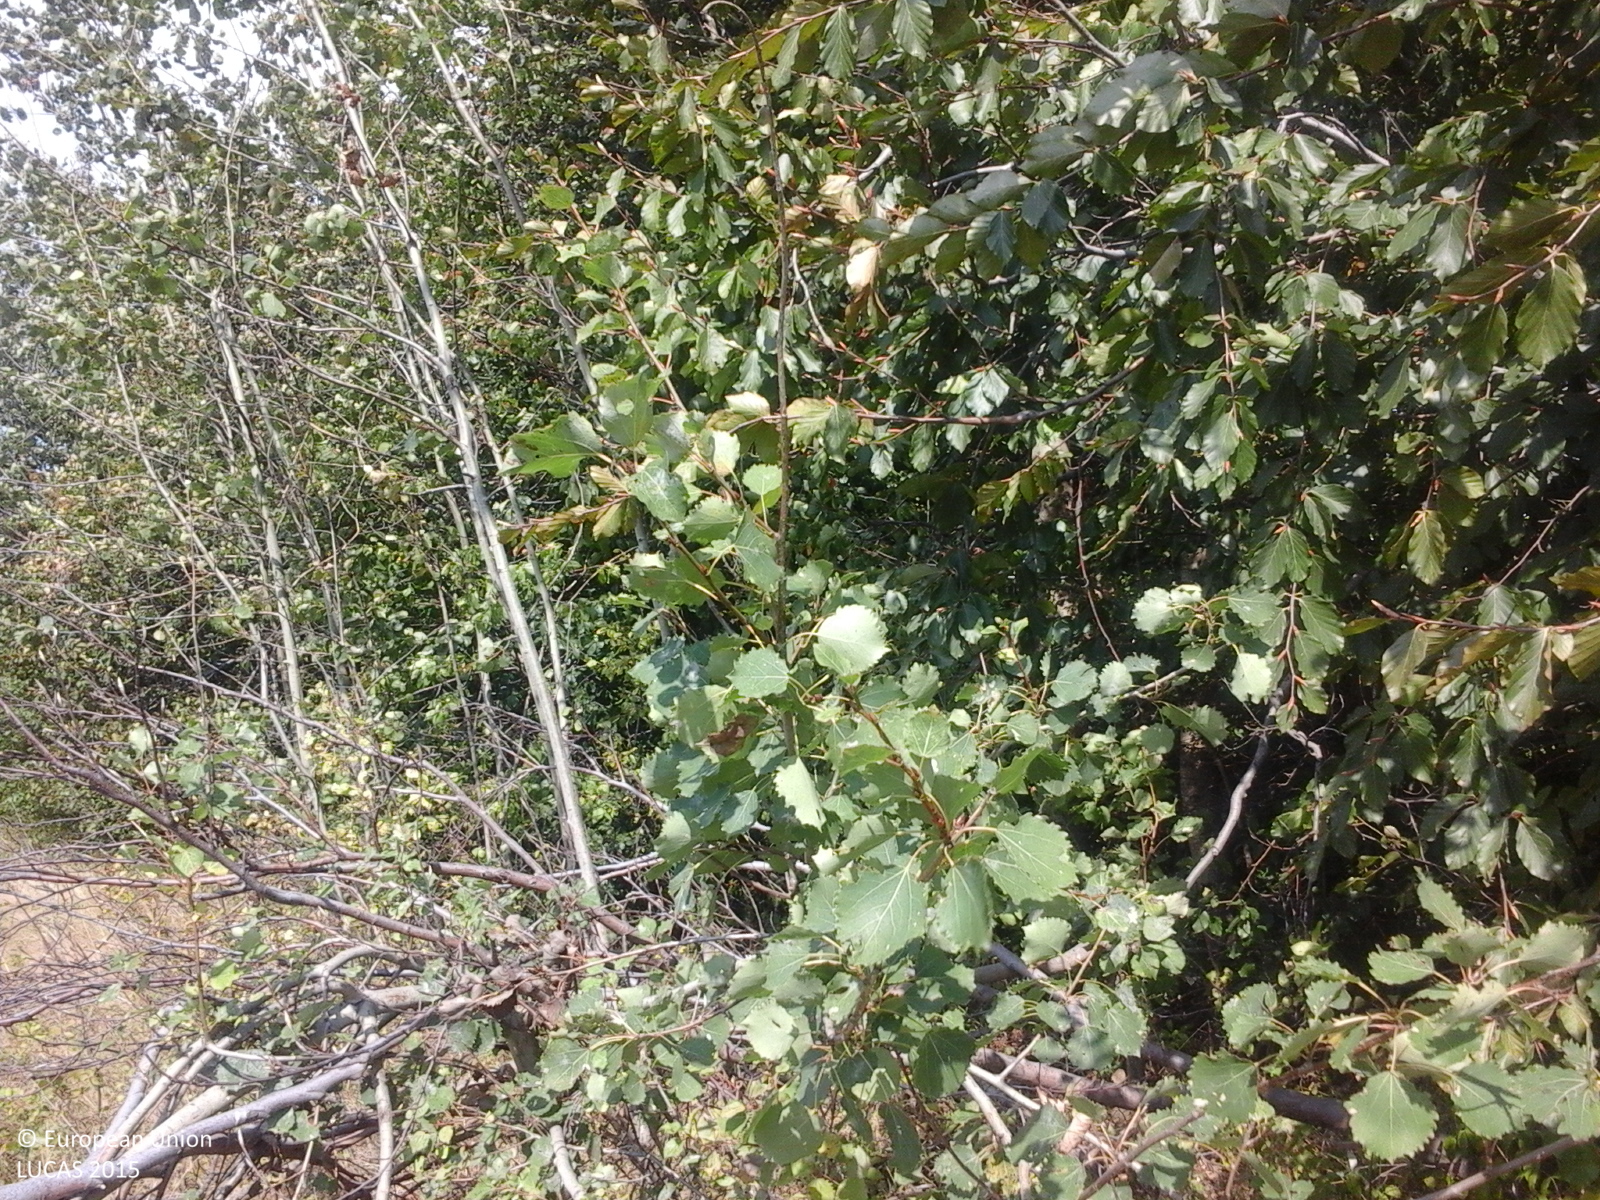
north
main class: Grassland
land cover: Grassland with sparse tree/shrub cover
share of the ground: > 75 %
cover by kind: herbaceous plants 90 %, broadleaved forest trees 5 %, shrubs 5 %
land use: Agriculture (excluding fallow land and kitchen gardens)
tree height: < 5 m
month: September
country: RO
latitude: 45.1745
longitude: 22.2167
